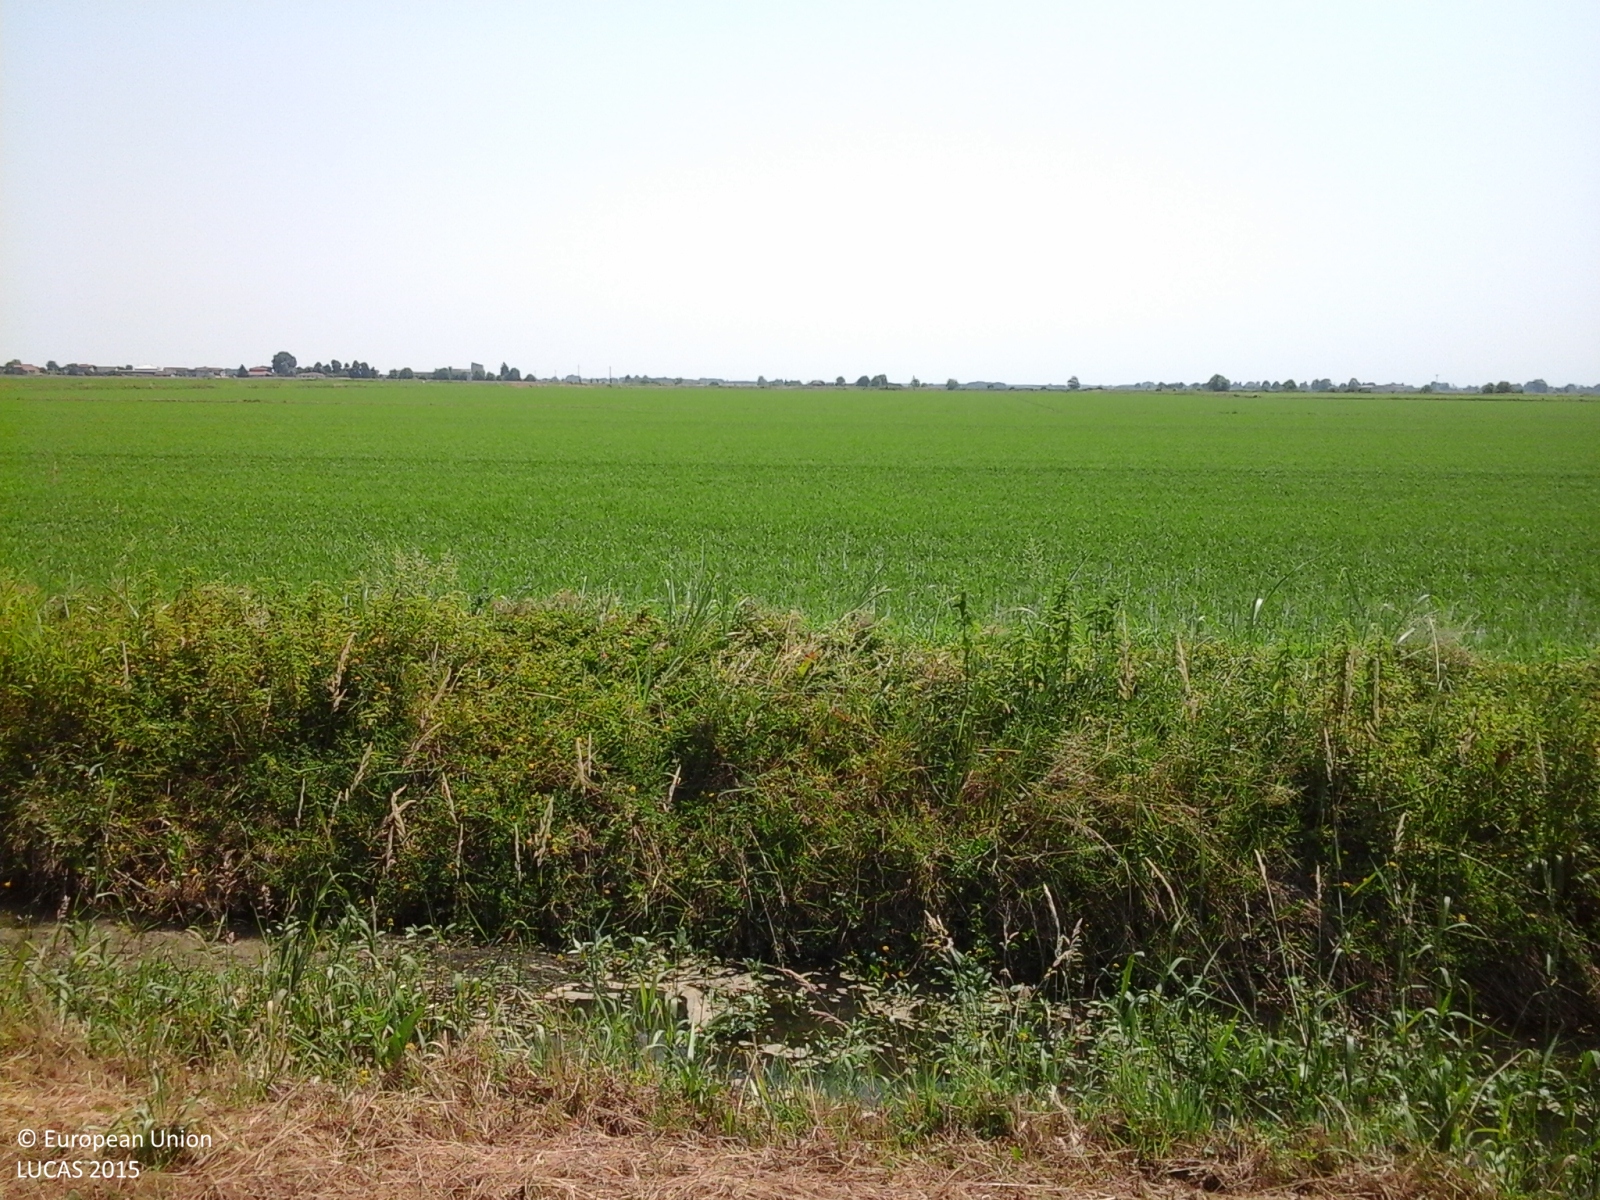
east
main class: Cropland
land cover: Rice
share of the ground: 25 - 50 %
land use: Agriculture (excluding fallow land and kitchen gardens)
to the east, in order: Rice; Grass margins; Tracks; Grass margins; Ditches and canals; Grass margins; Other structural elements; Rice; Ditches and canals; Rice; Ditches and canals; Rice; Other structural elements; Rice; Ditches and canals; Rice
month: June
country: IT
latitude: 45.2224
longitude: 8.4363
